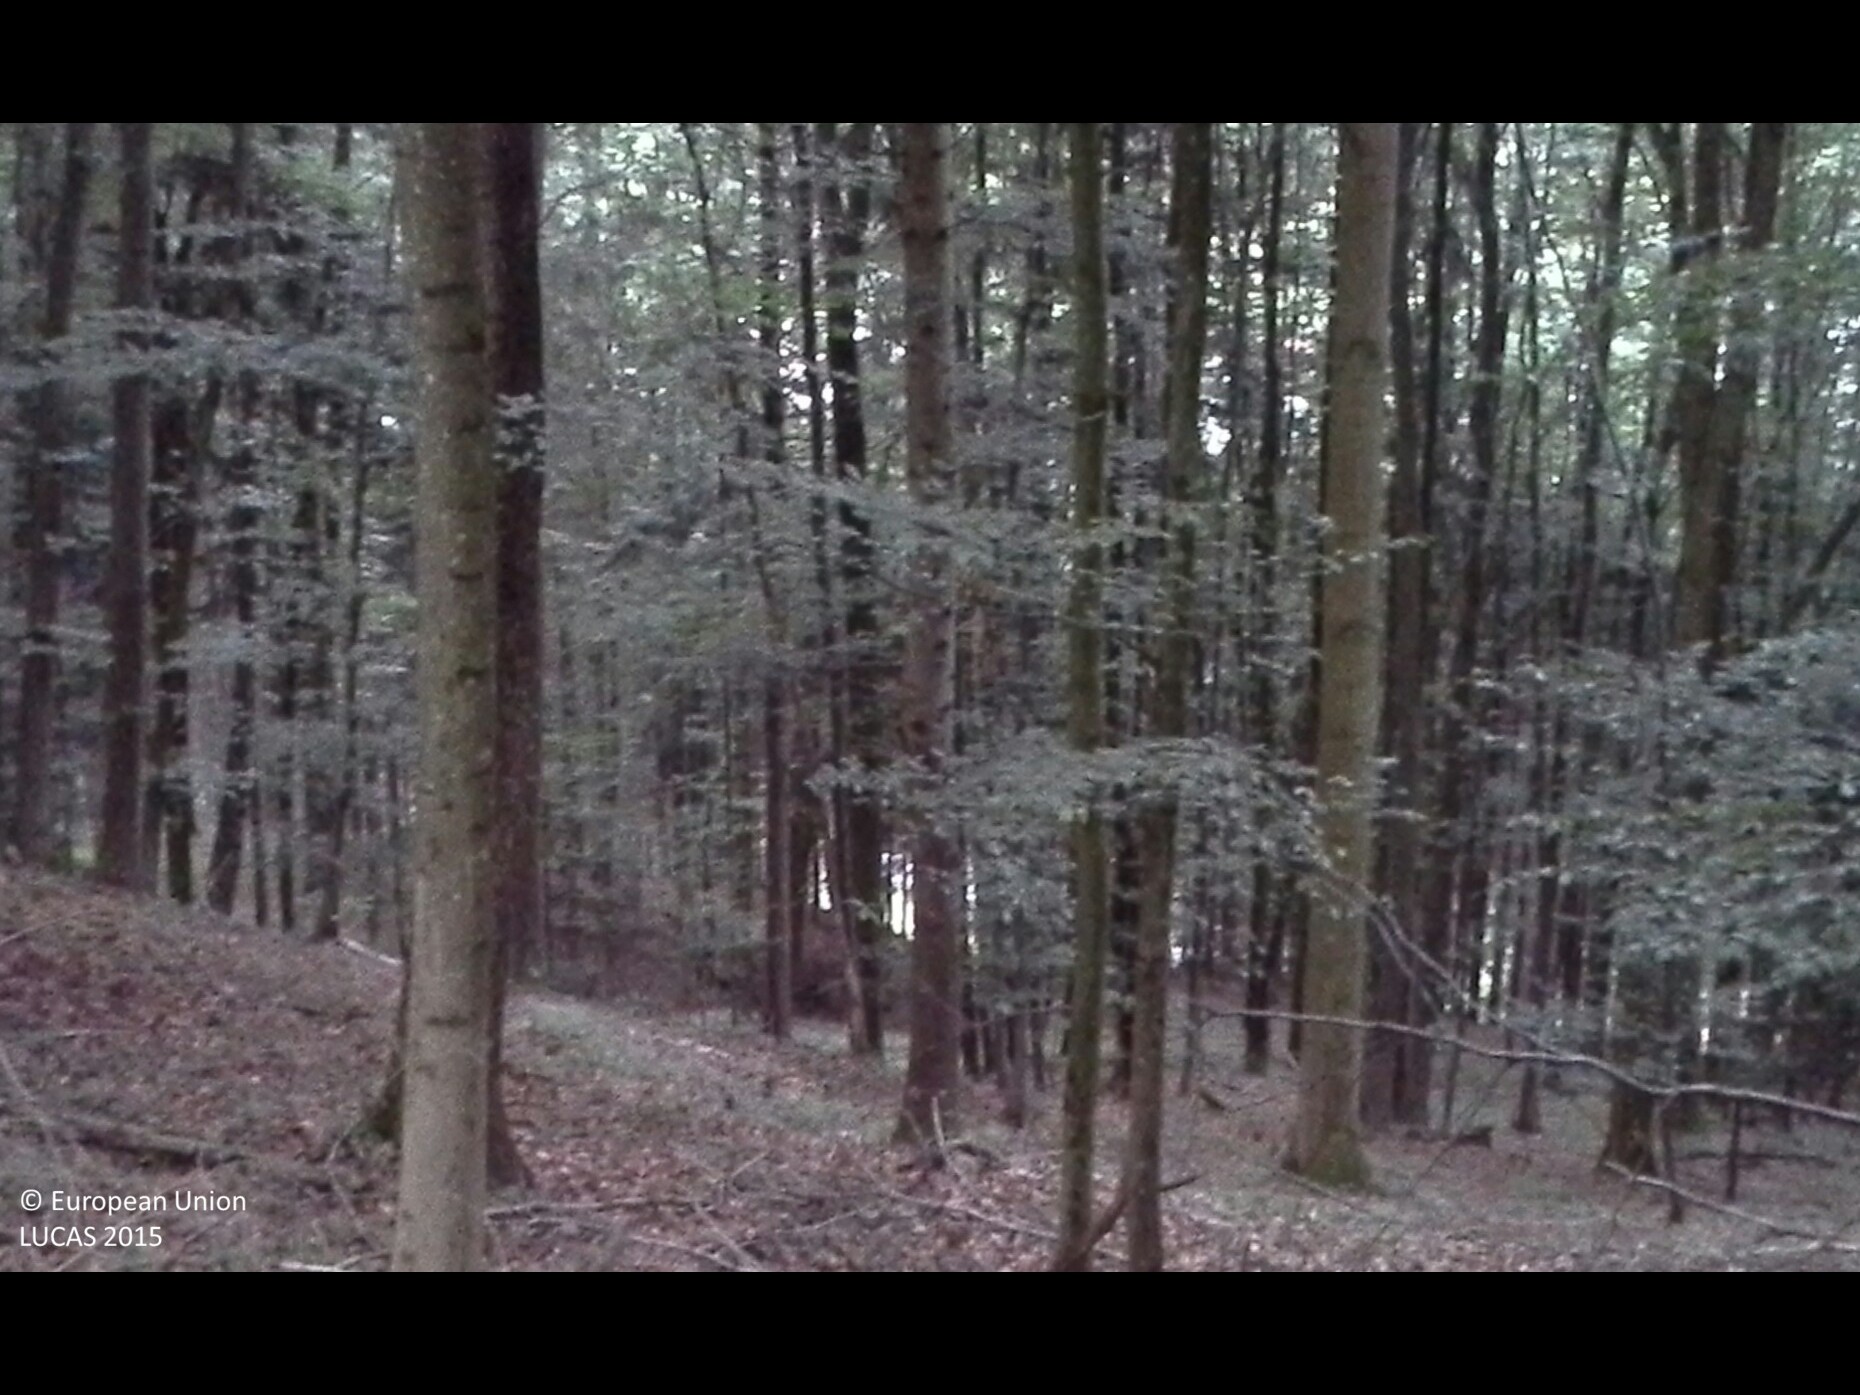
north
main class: Woodland
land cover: Spruce dominated mixed woodland
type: beech forest
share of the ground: > 75 %
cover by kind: broadleaved forest trees 55 %, coniferous forest trees 30 %, herbaceous plants 15 %
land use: Forestry
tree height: > 5 m
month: June
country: AT
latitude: 47.9912
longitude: 14.4086
